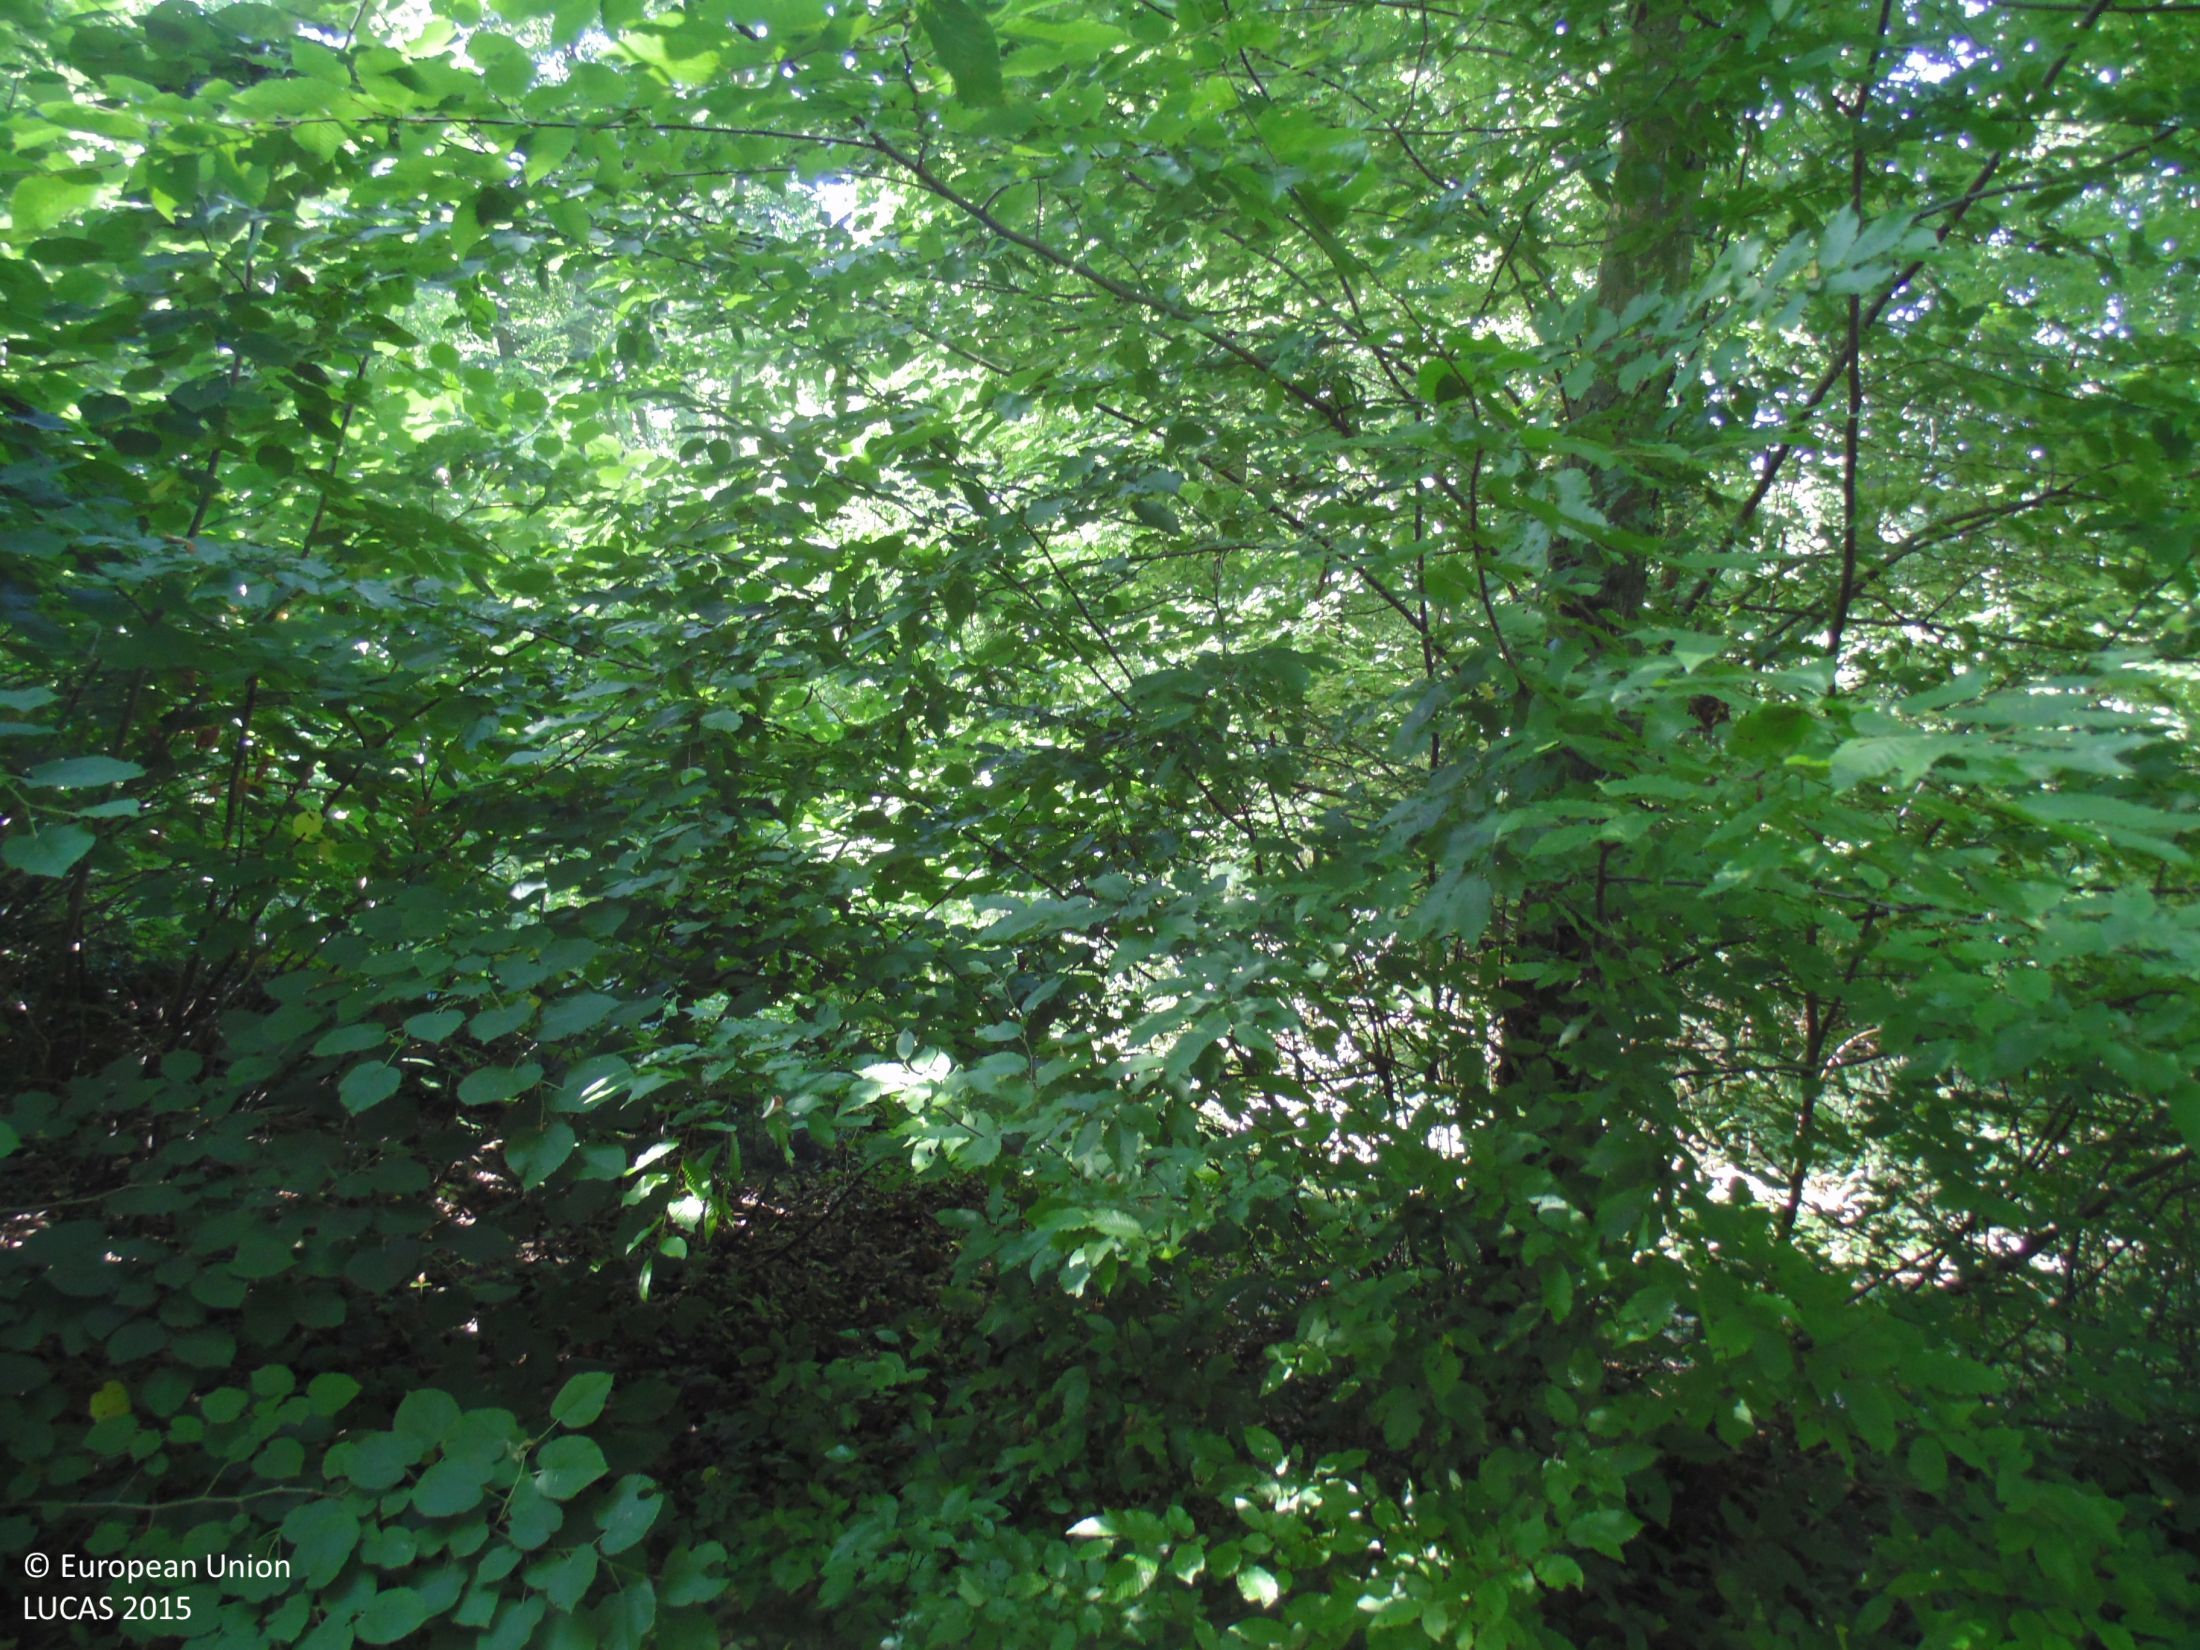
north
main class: Woodland
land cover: Broadleaved woodland
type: mesophytic deciduous forest
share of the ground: > 75 %
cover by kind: broadleaved forest trees 90 %, shrubs 10 %
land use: Forestry
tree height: > 5 m
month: July
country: BG
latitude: 43.3908
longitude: 27.9825
